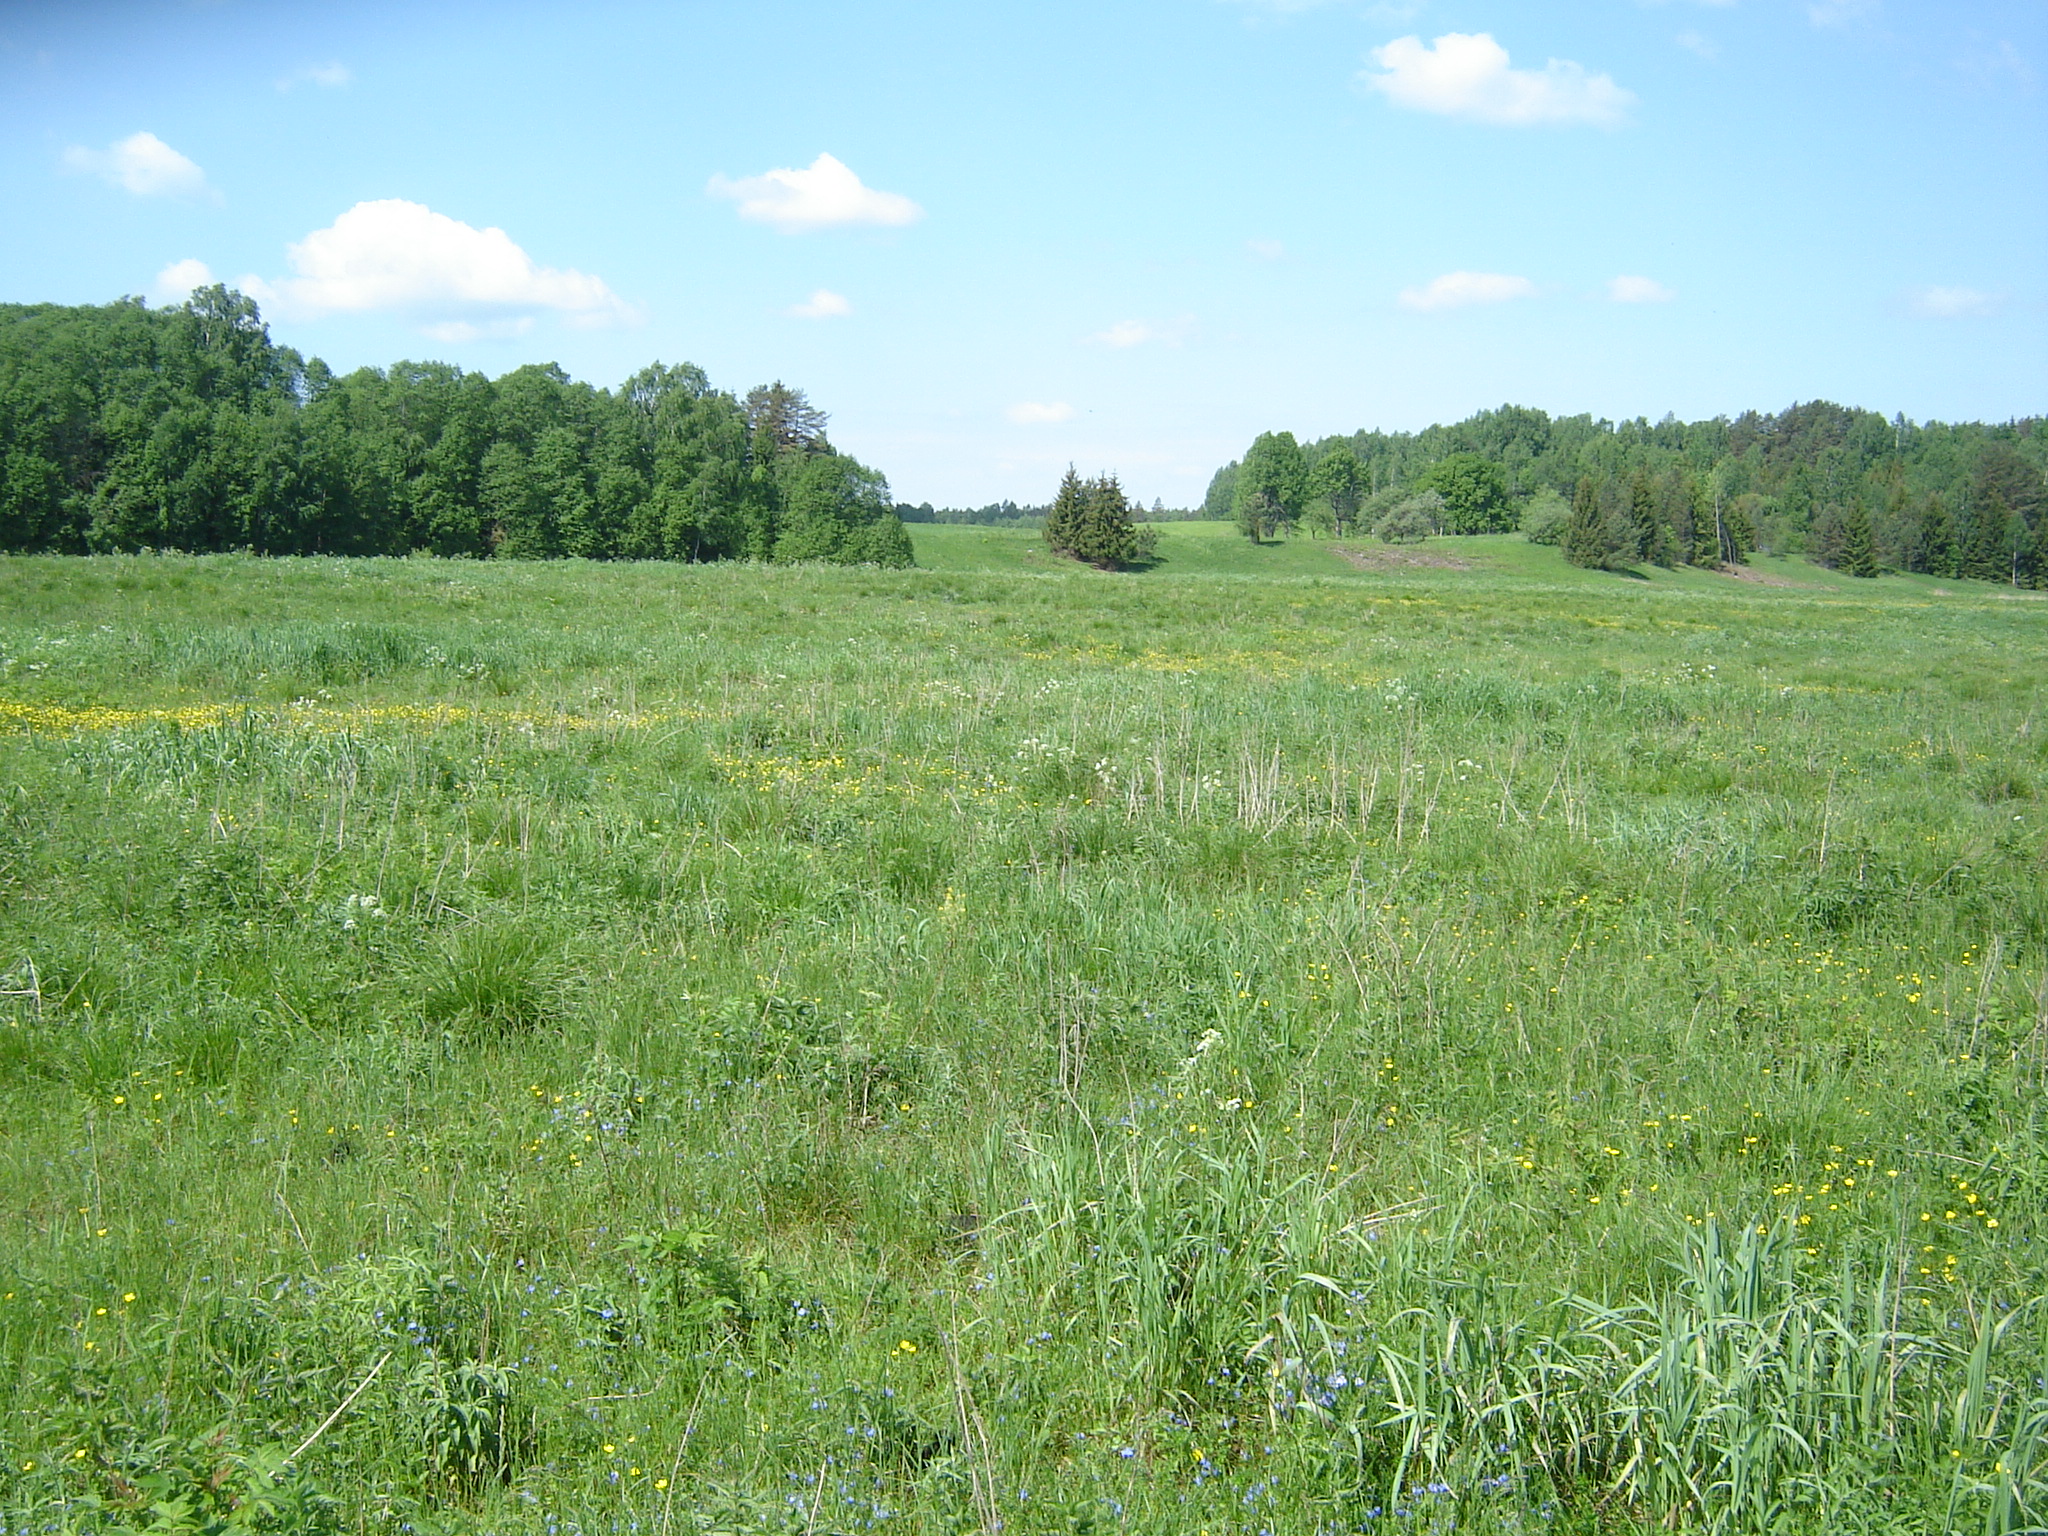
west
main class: Grassland
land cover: Spontaneously vegetated surfaces
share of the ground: > 75 %
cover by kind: herbaceous plants 100 %
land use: Semi-natural and natural areas not in use
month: May
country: LT
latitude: 55.6831
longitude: 25.3077
